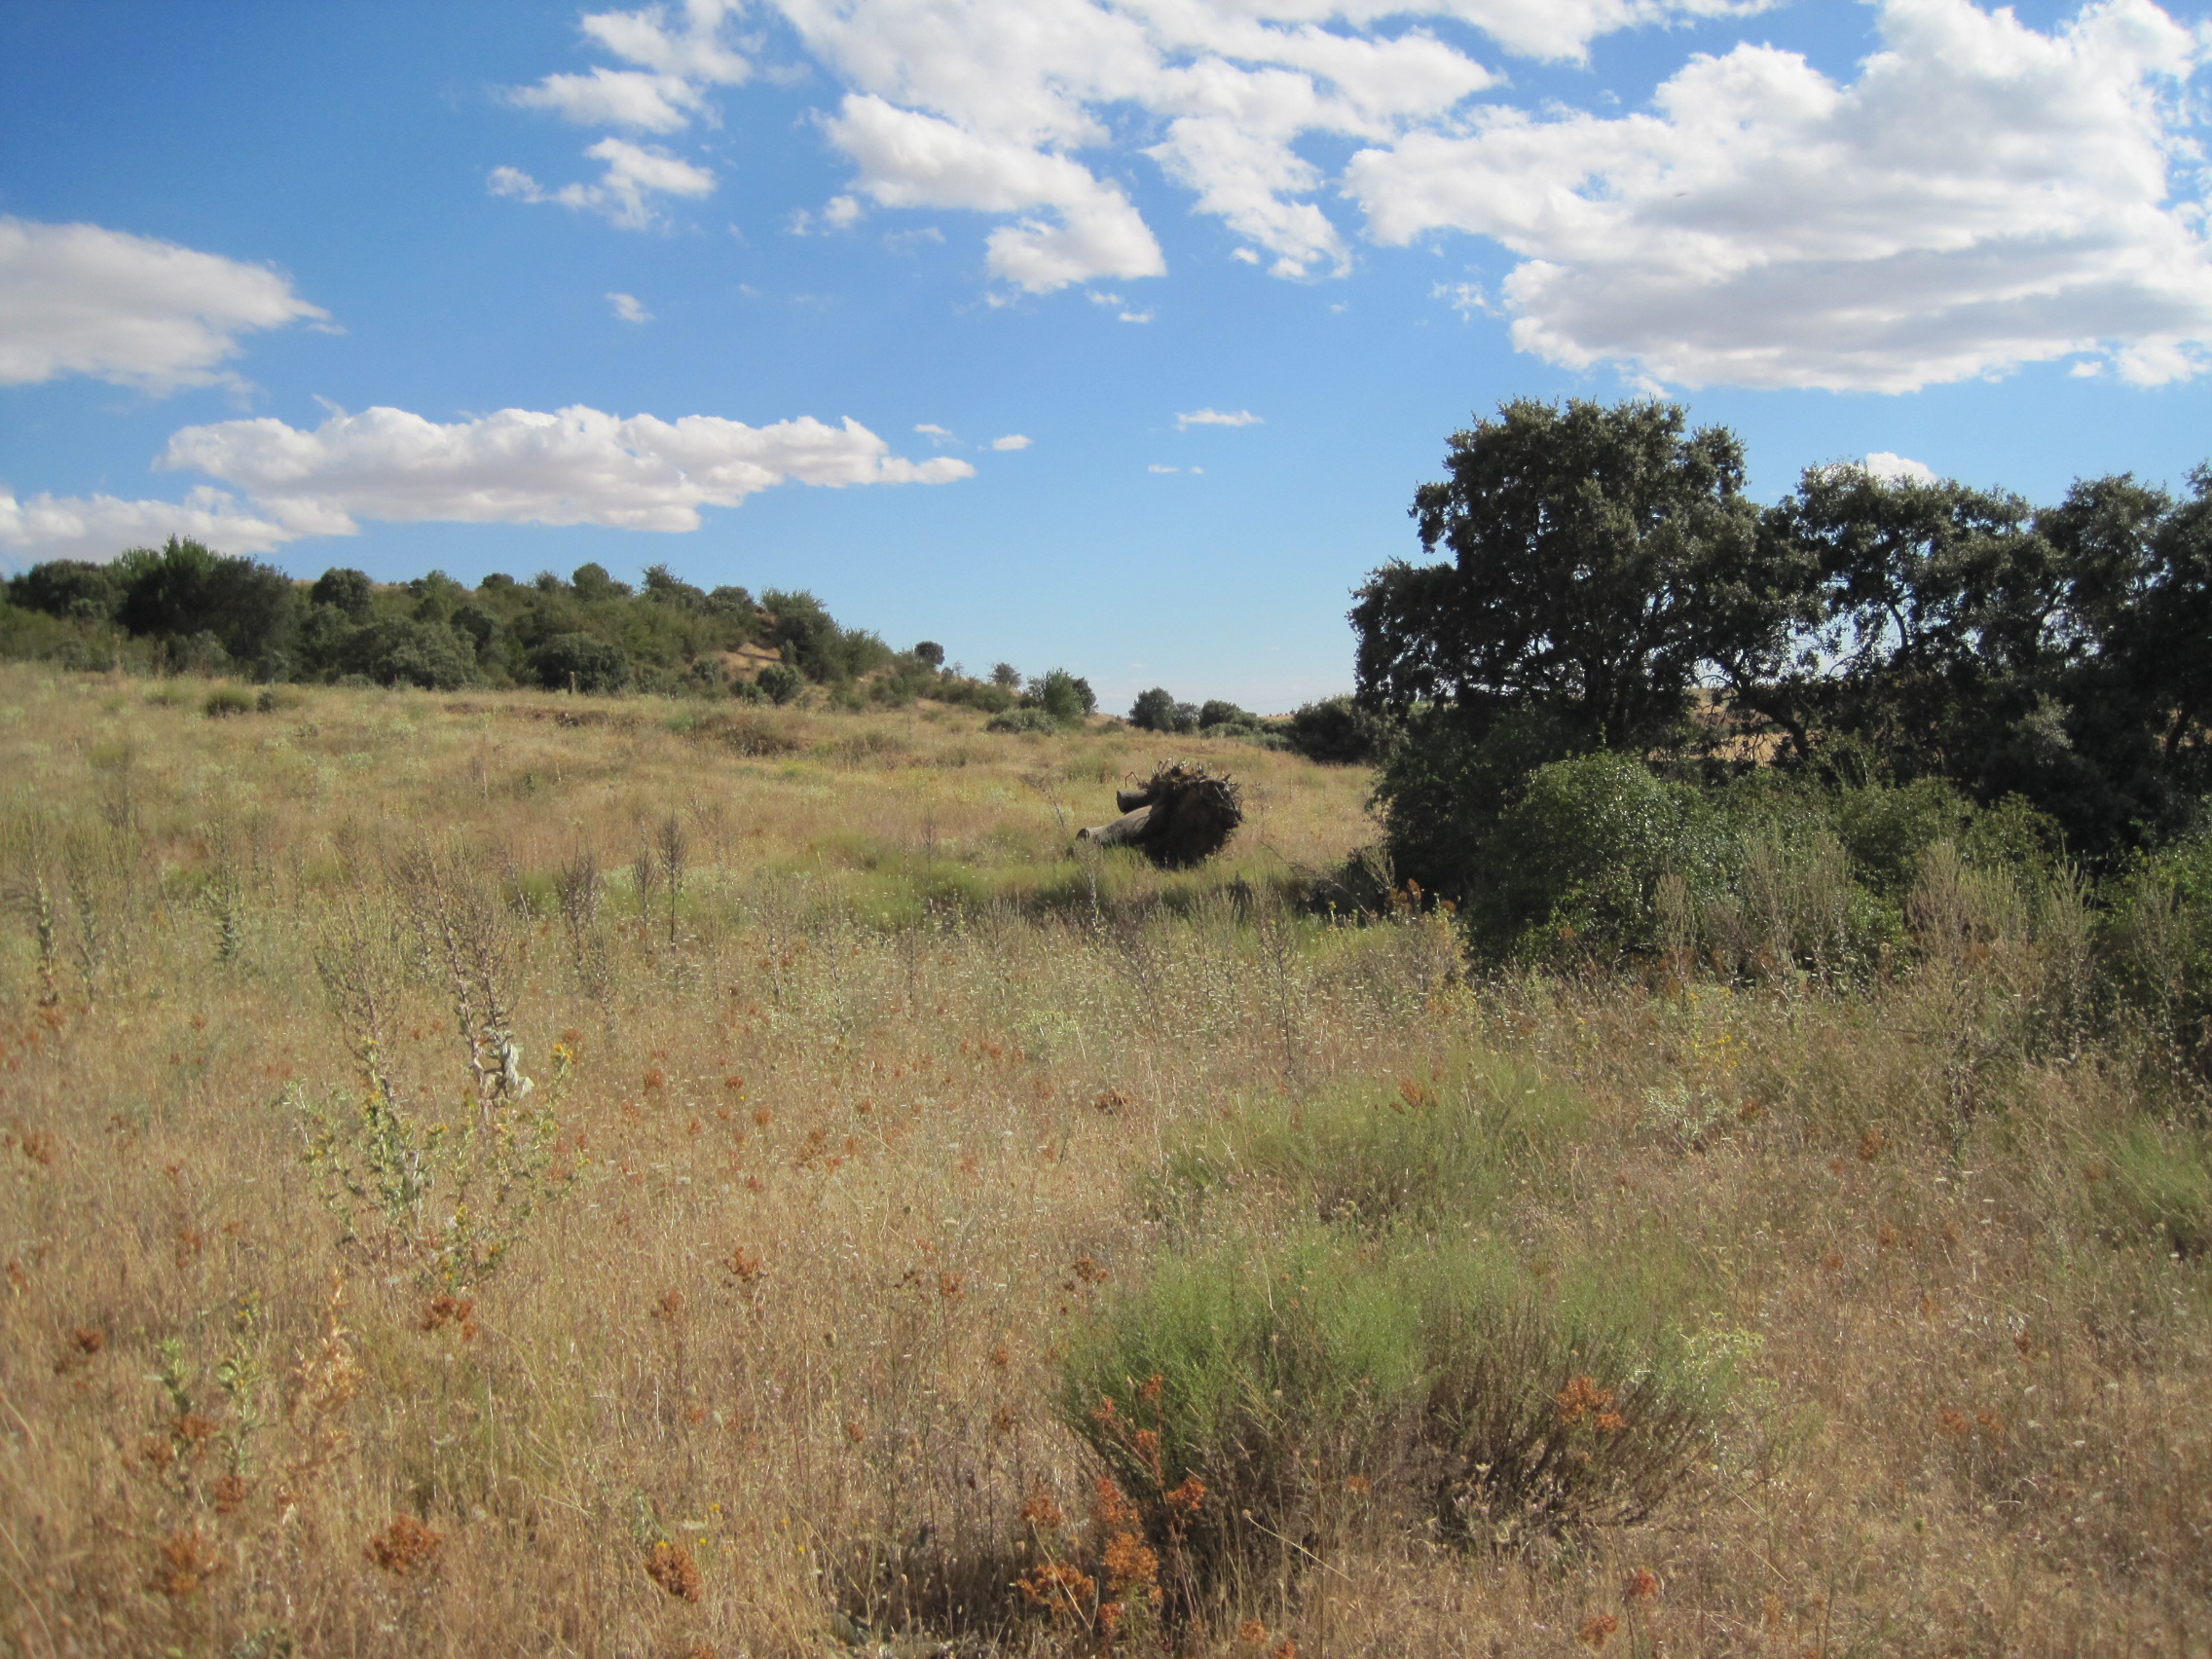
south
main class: Grassland
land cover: Grassland without tree/shrub cover
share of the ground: > 75 %
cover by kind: herbaceous plants 95 %, shrubs 5 %
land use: Semi-natural and natural areas not in use
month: July
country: ES
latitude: 42.0978
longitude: -5.4813
